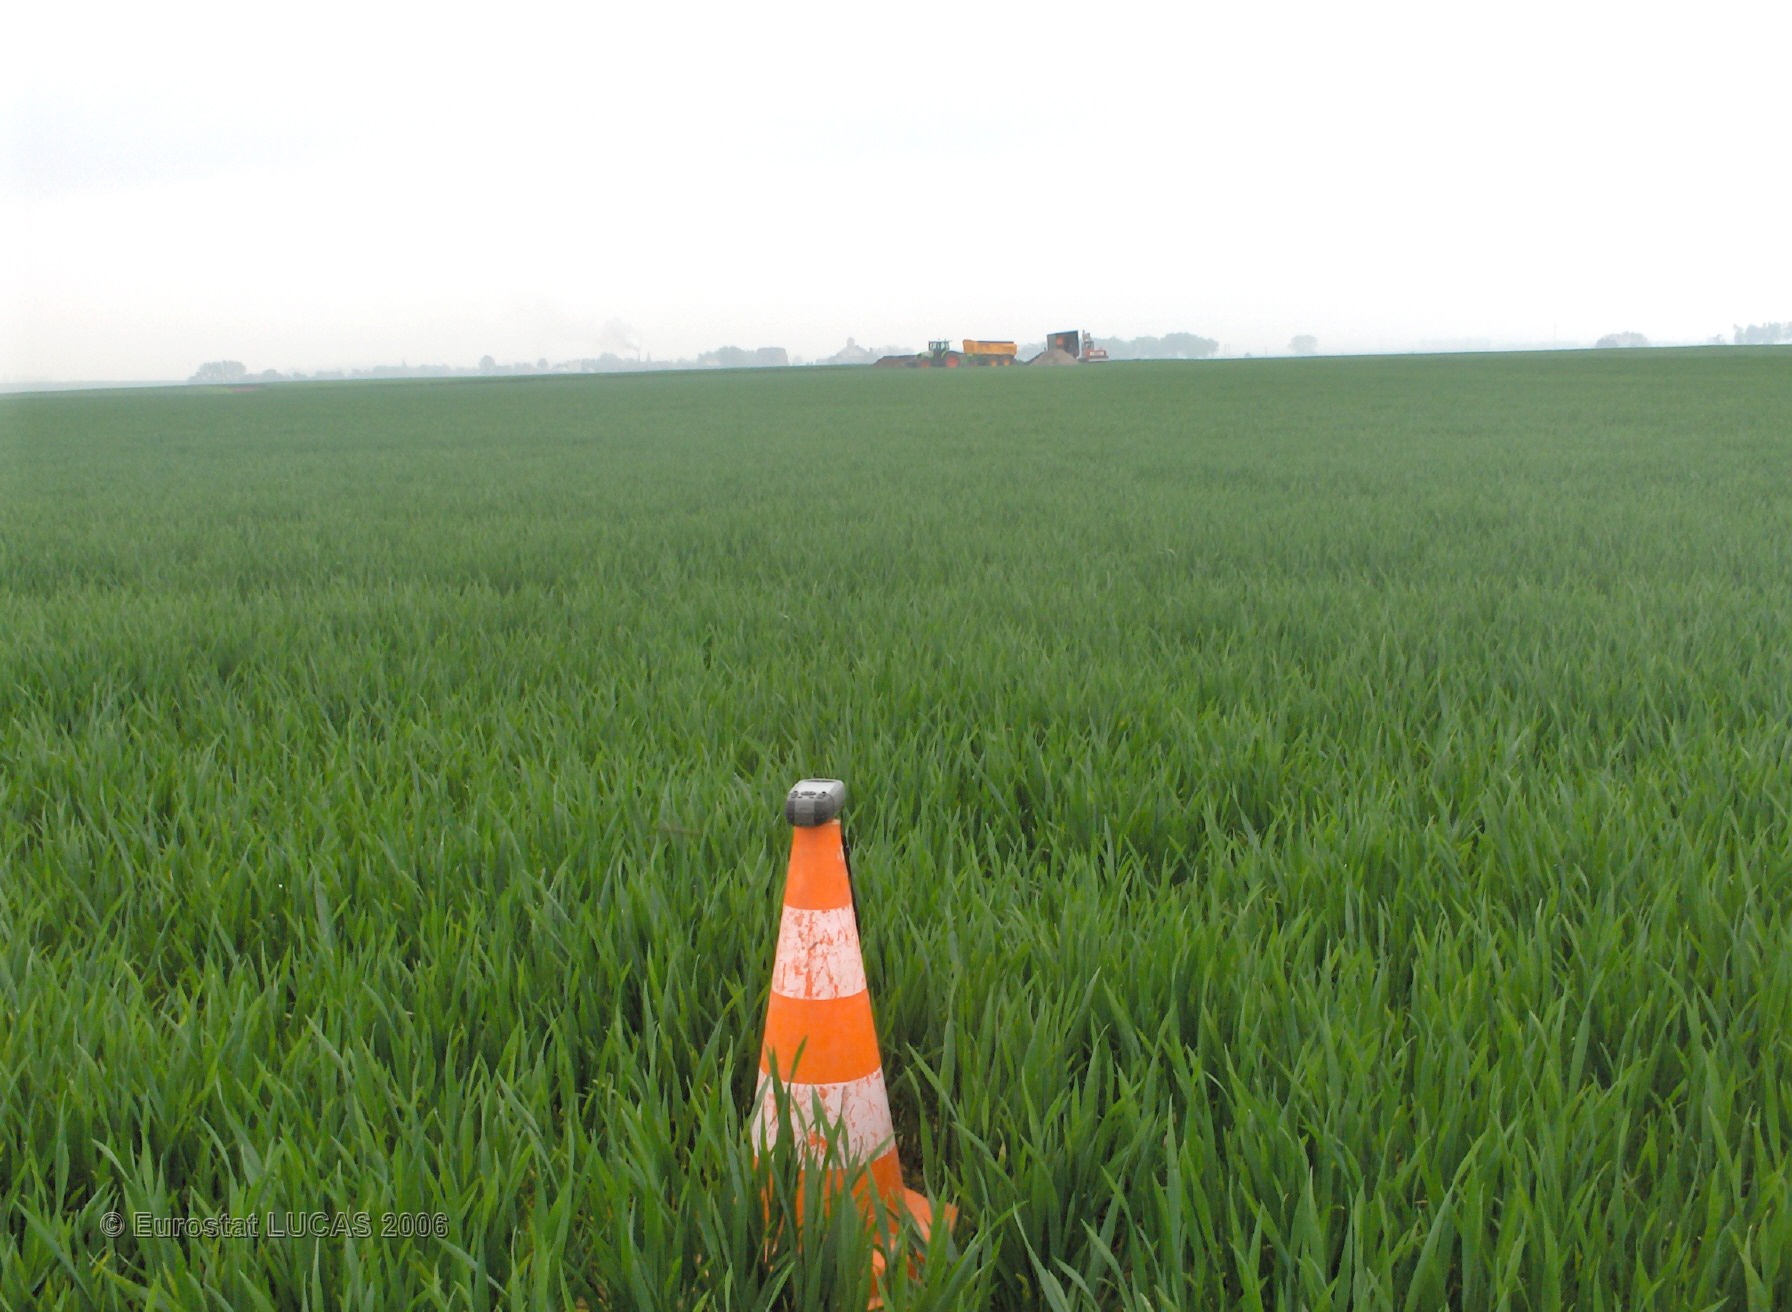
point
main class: Cropland
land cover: Common wheat
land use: Agriculture (excluding fallow land and kitchen gardens)
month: May
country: BE
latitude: 50.5385
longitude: 4.5071
